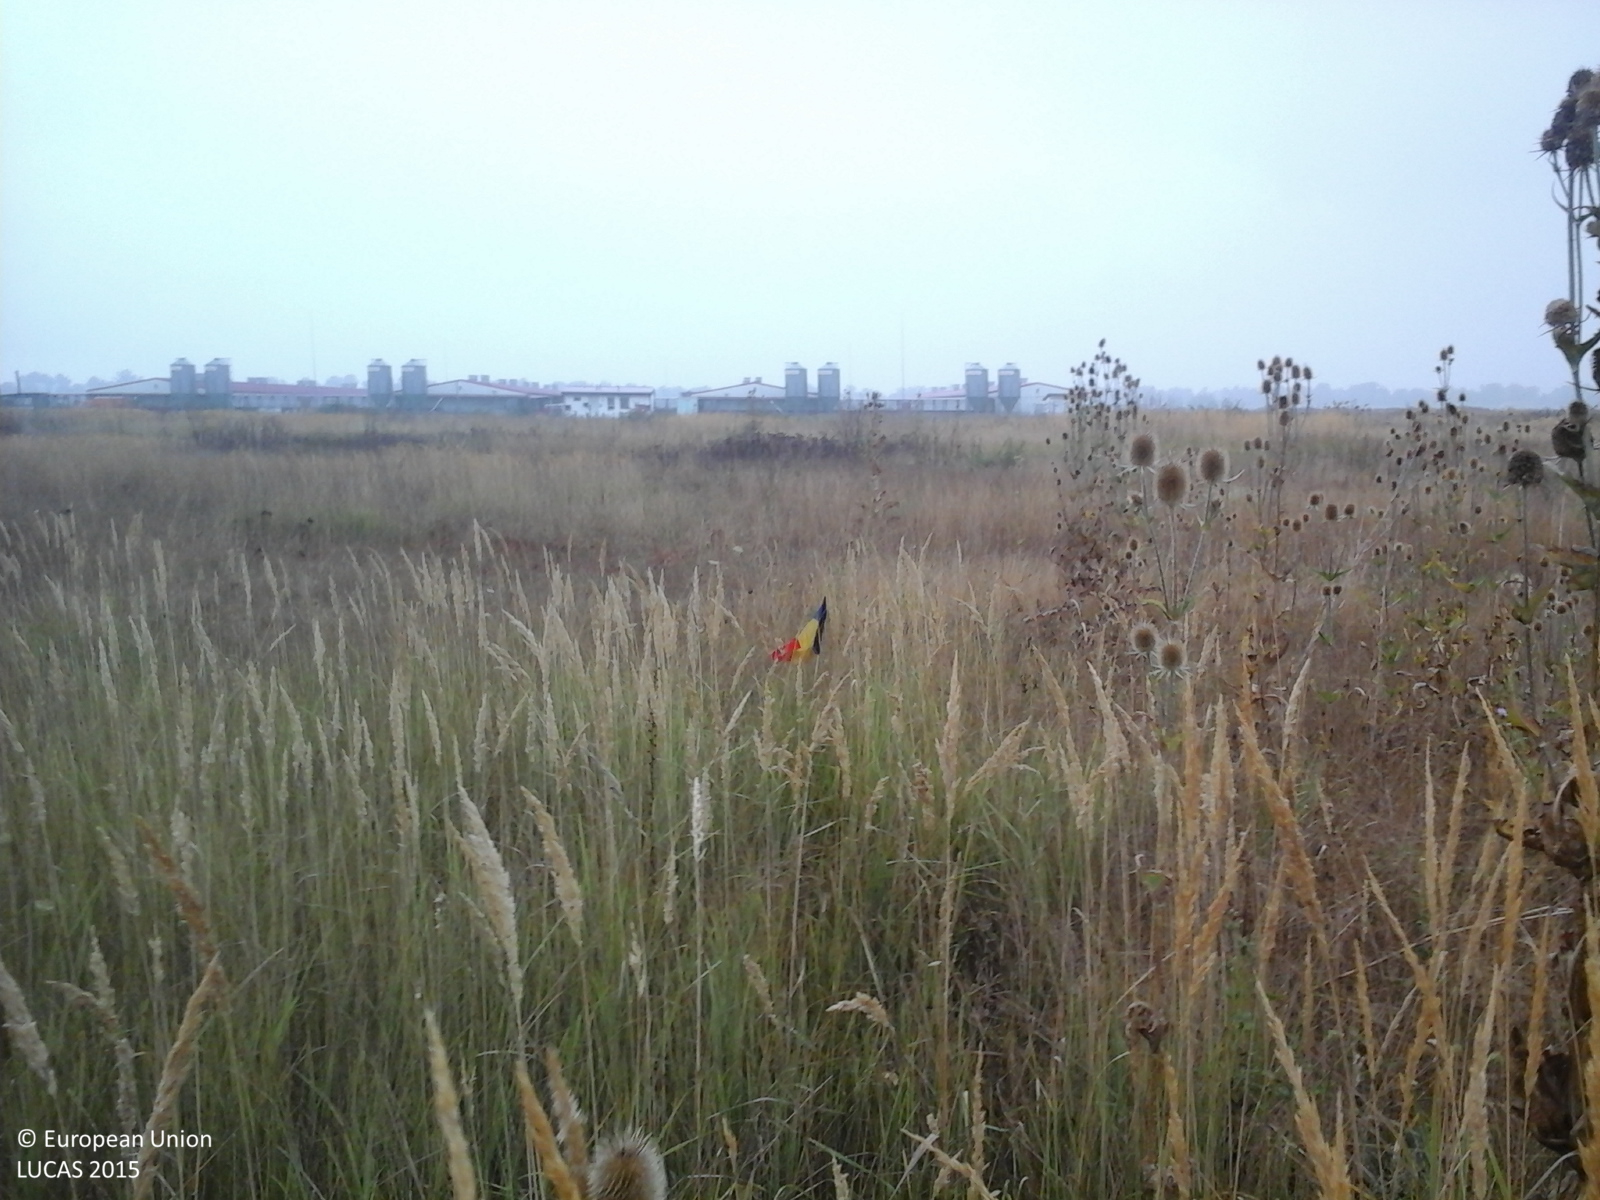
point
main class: Grassland
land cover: Spontaneously vegetated surfaces
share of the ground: > 75 %
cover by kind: herbaceous plants 100 %
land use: Fallow land
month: August
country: RO
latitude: 46.0701
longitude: 20.8495
